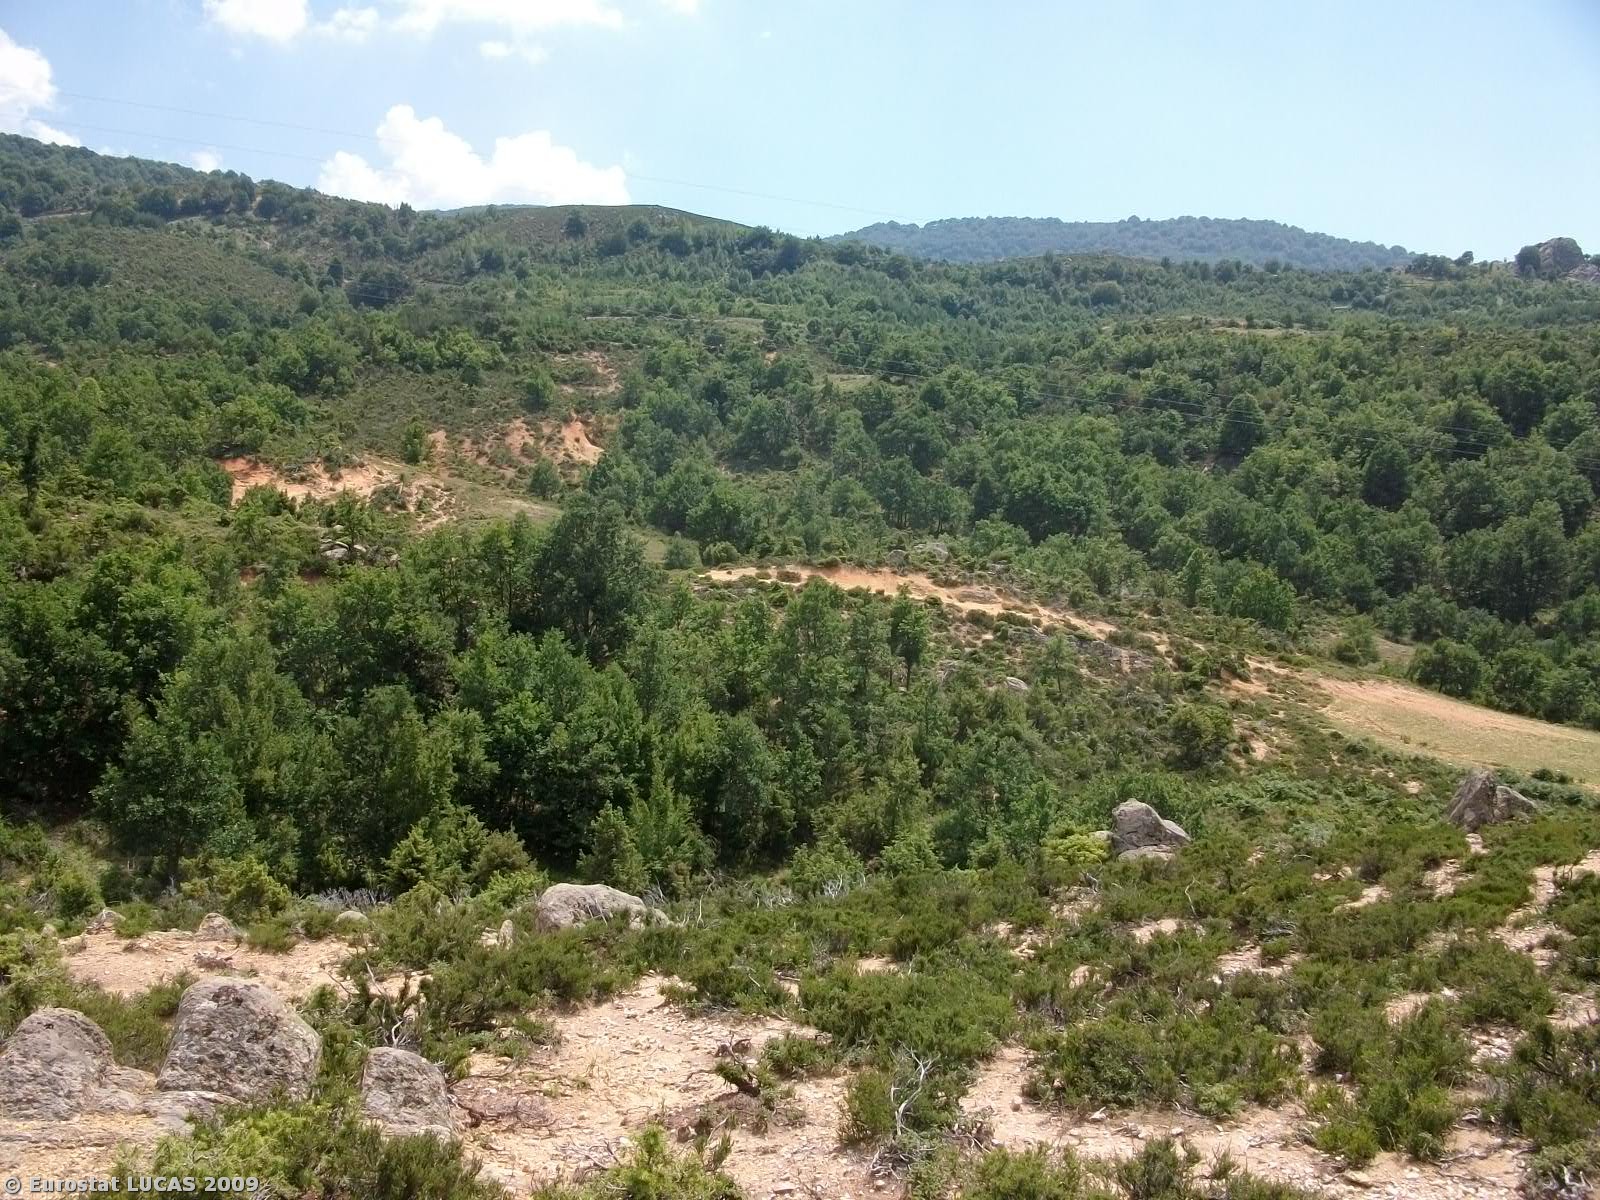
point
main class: Woodland
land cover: Mixed woodland
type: coniferous forest of the mediterranean region
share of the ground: > 75 %
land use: Nature reserves
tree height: > 5 m
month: July
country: GR
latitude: 40.4805
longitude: 23.5192
